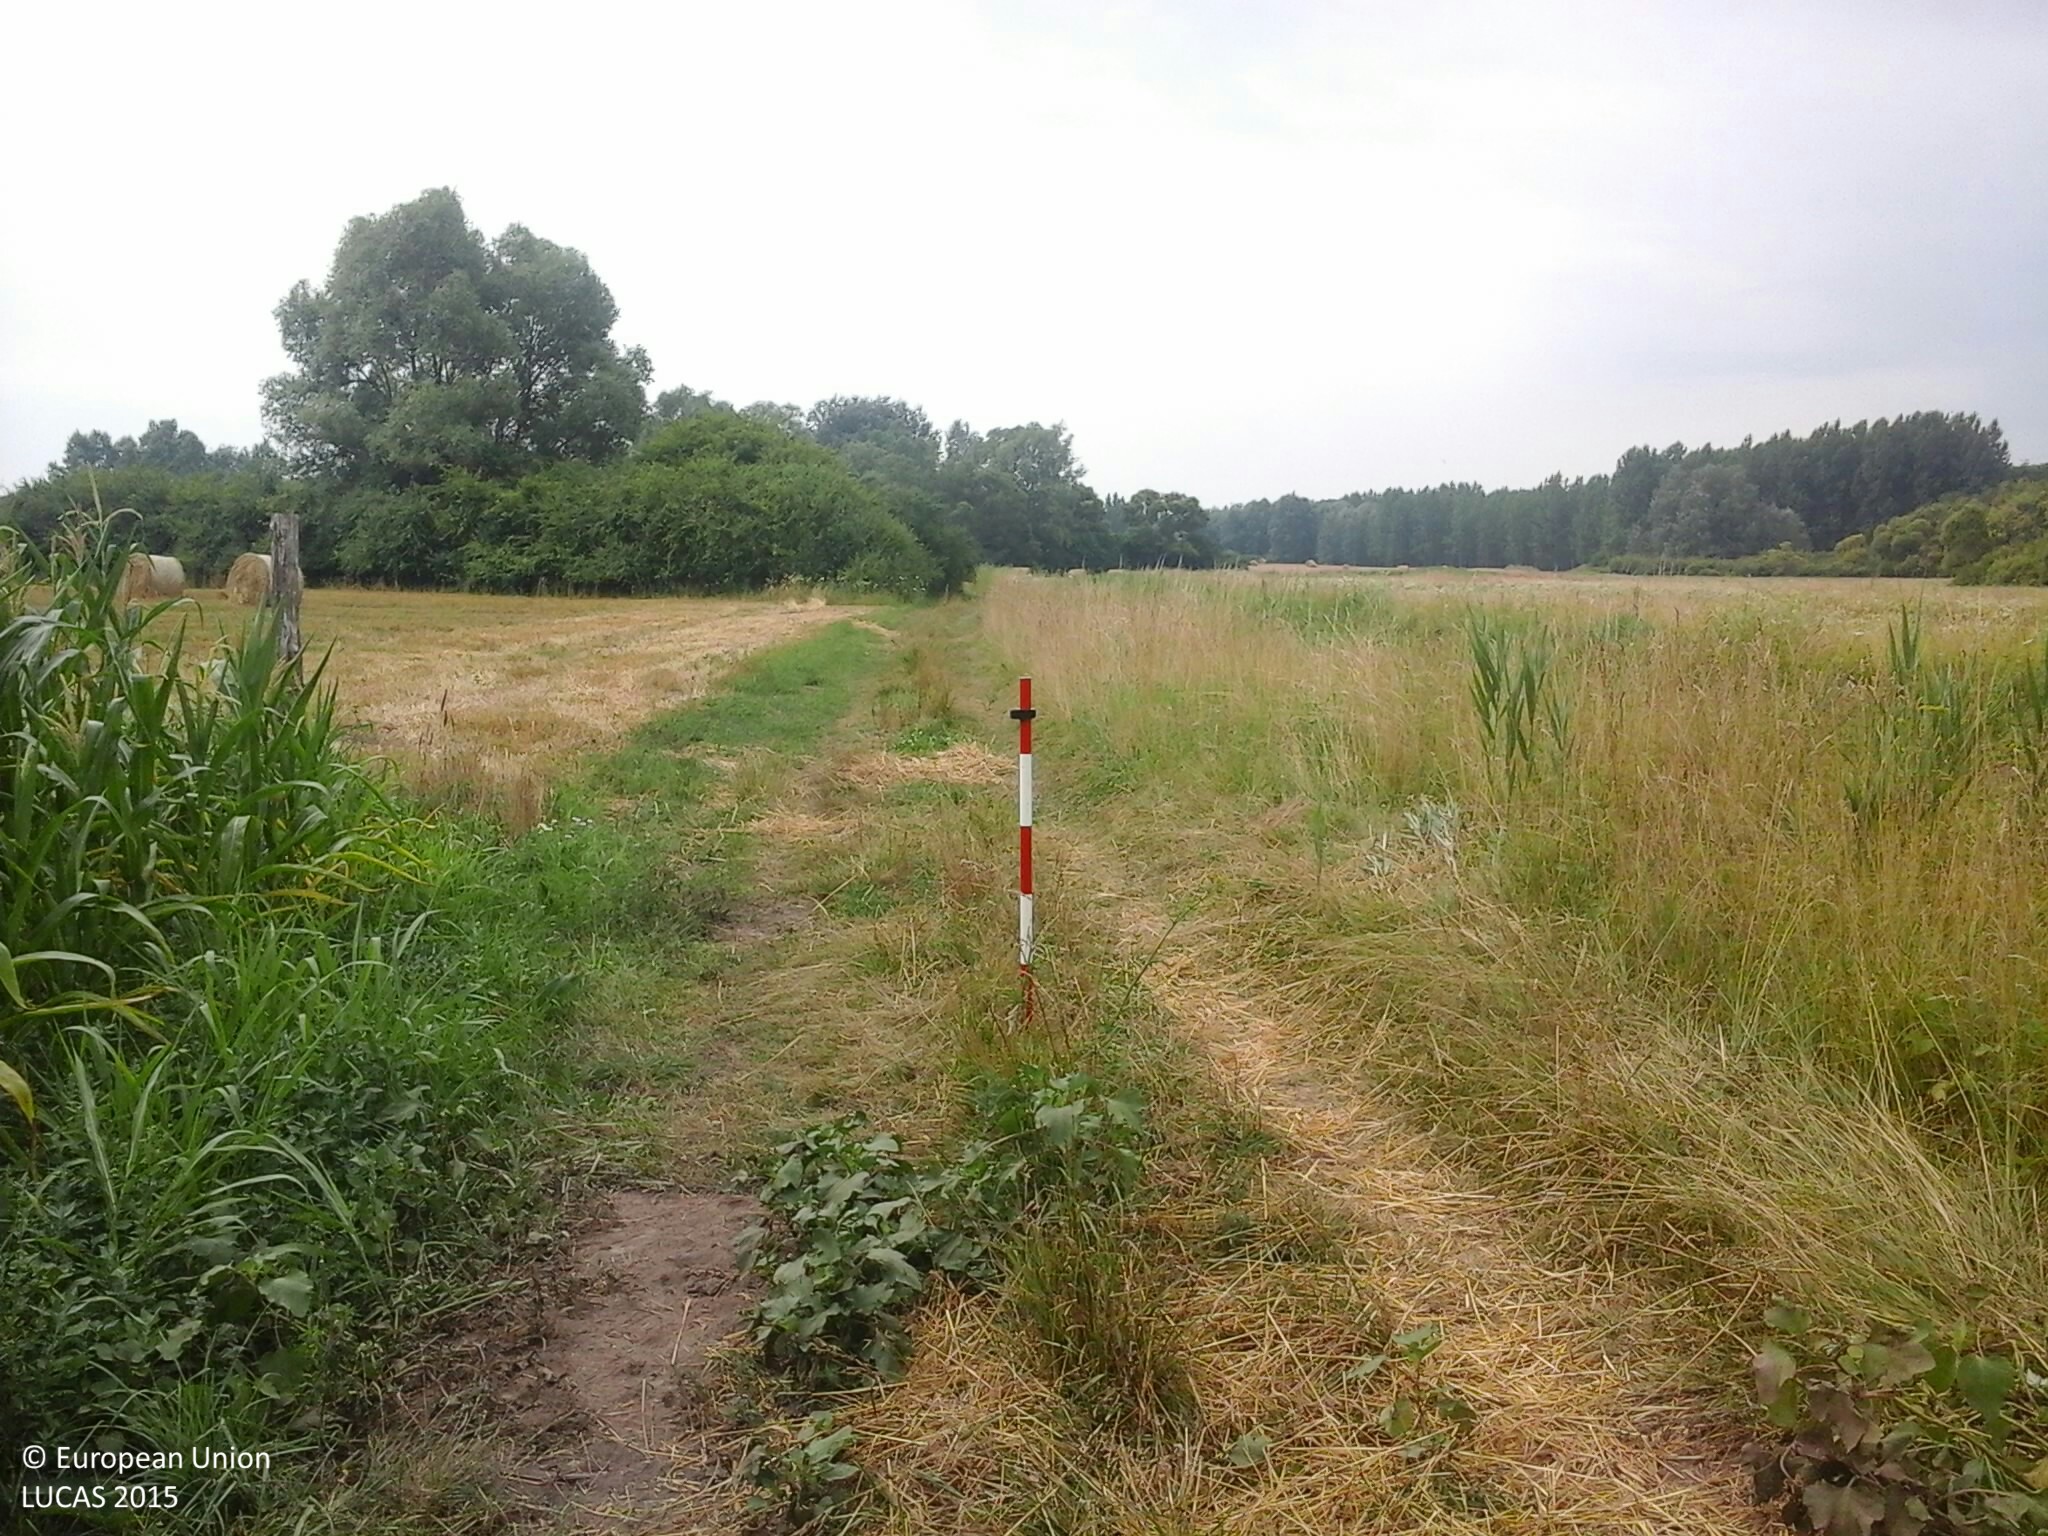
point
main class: Cropland
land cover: Maize
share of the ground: > 75 %
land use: Agriculture (excluding fallow land and kitchen gardens)
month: July
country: HU
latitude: 47.6867
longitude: 22.2170
